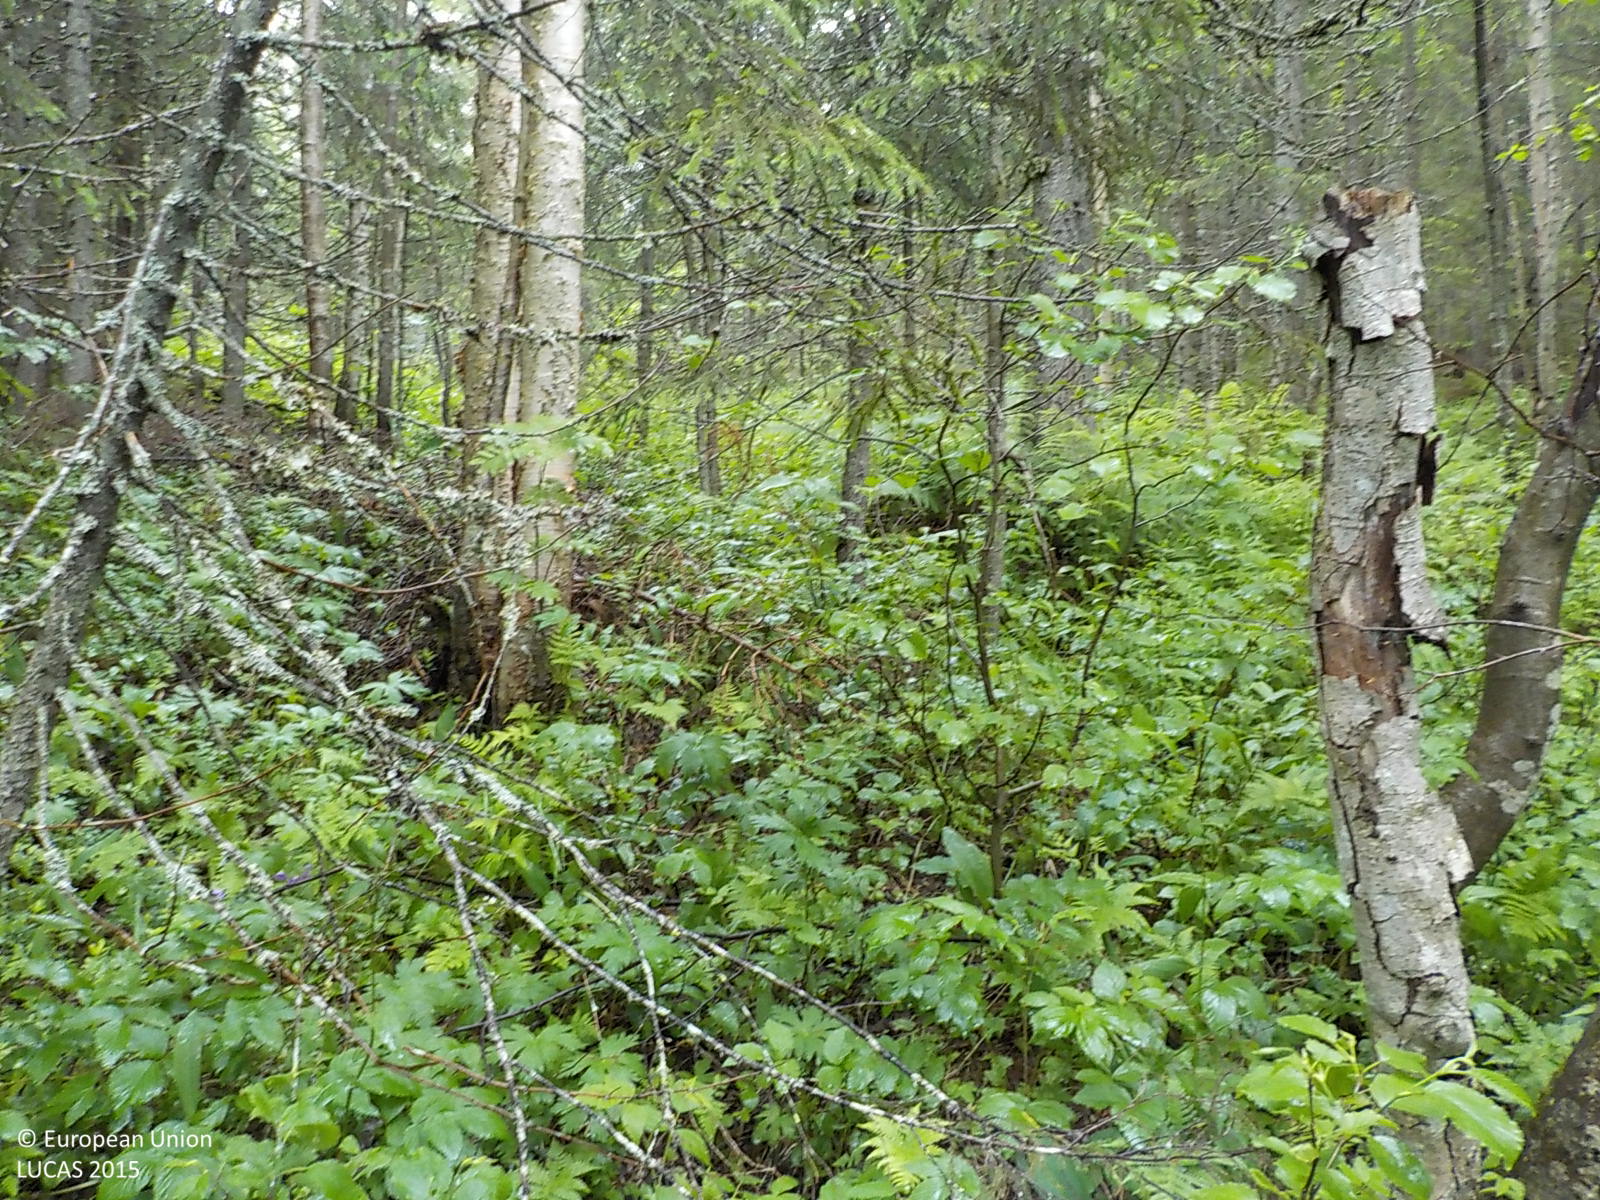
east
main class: Woodland
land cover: Spruce dominated mixed woodland
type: boreal forest
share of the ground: > 75 %
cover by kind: coniferous forest trees 60 %, broadleaved forest trees 20 %, herbaceous plants 20 %
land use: Forestry
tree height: > 5 m
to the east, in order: Spruce dominated mixed woodland; Pine dominated mixed woodland; Grassland with sparse tree/shrub cover; Spruce dominated coniferous woodland; Paved roads, cycling and walking lanes; Ditches and canals; Grassland with sparse tree/shrub cover
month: July
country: SE
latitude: 63.0889
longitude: 17.9981
